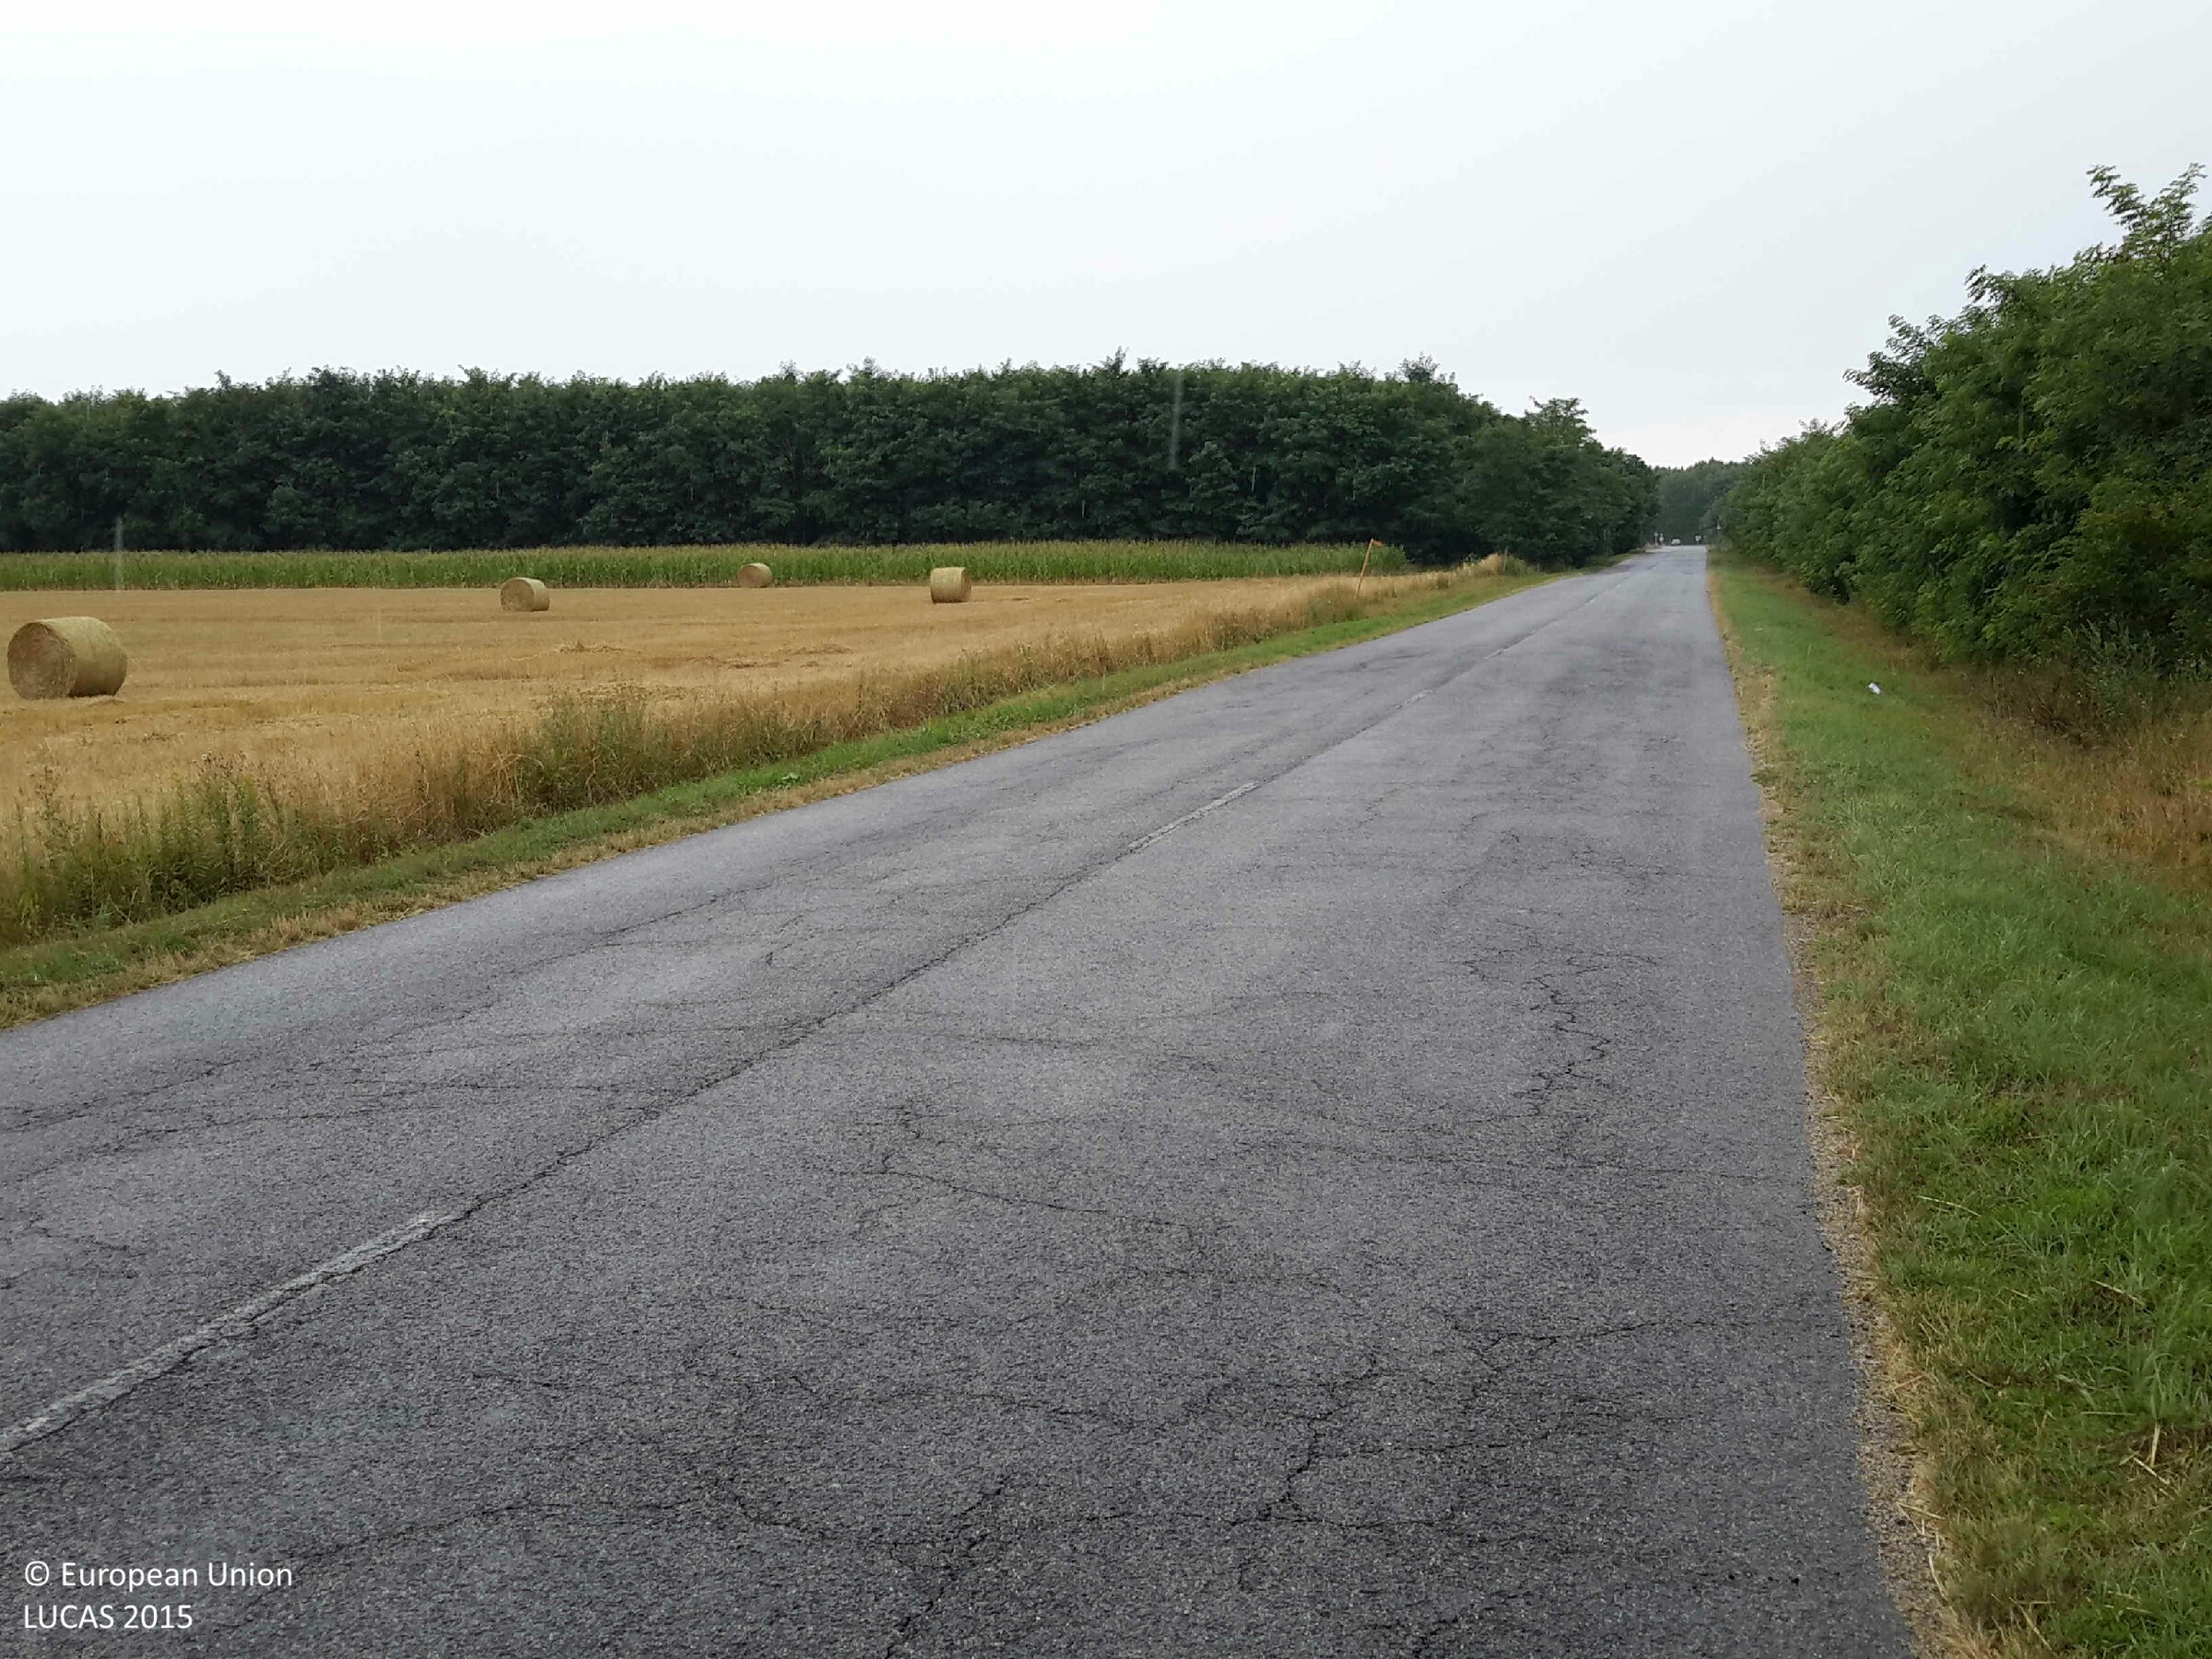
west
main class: Shrubland
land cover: Shrubland without tree cover
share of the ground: > 75 %
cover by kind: shrubs 100 %
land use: Forestry
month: July
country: HU
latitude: 47.4634
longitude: 17.4766
